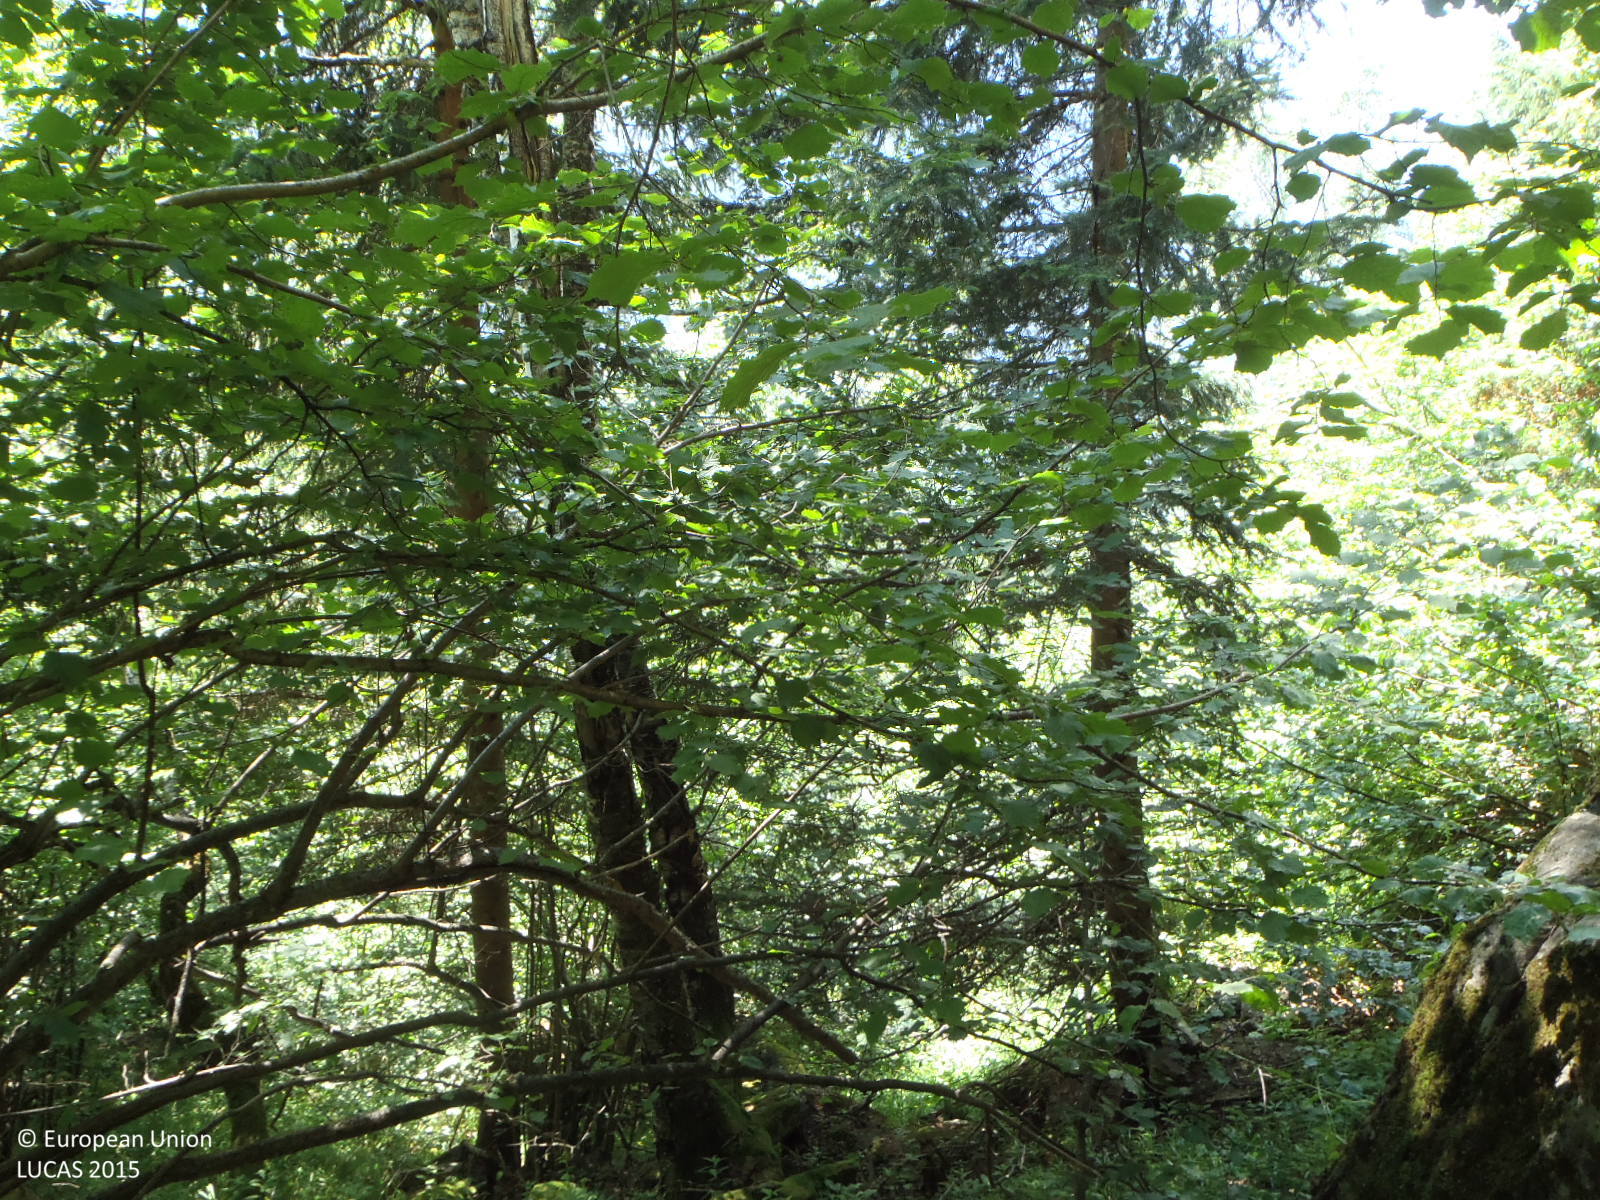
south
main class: Woodland
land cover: Broadleaved woodland
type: mountainous beech forest
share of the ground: > 75 %
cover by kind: broadleaved forest trees 75 %, coniferous forest trees 15 %, herbaceous plants 5 %, consolidated bare surface 5 %
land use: Forestry
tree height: > 5 m
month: July
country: AT
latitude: 47.0930
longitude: 11.7768
